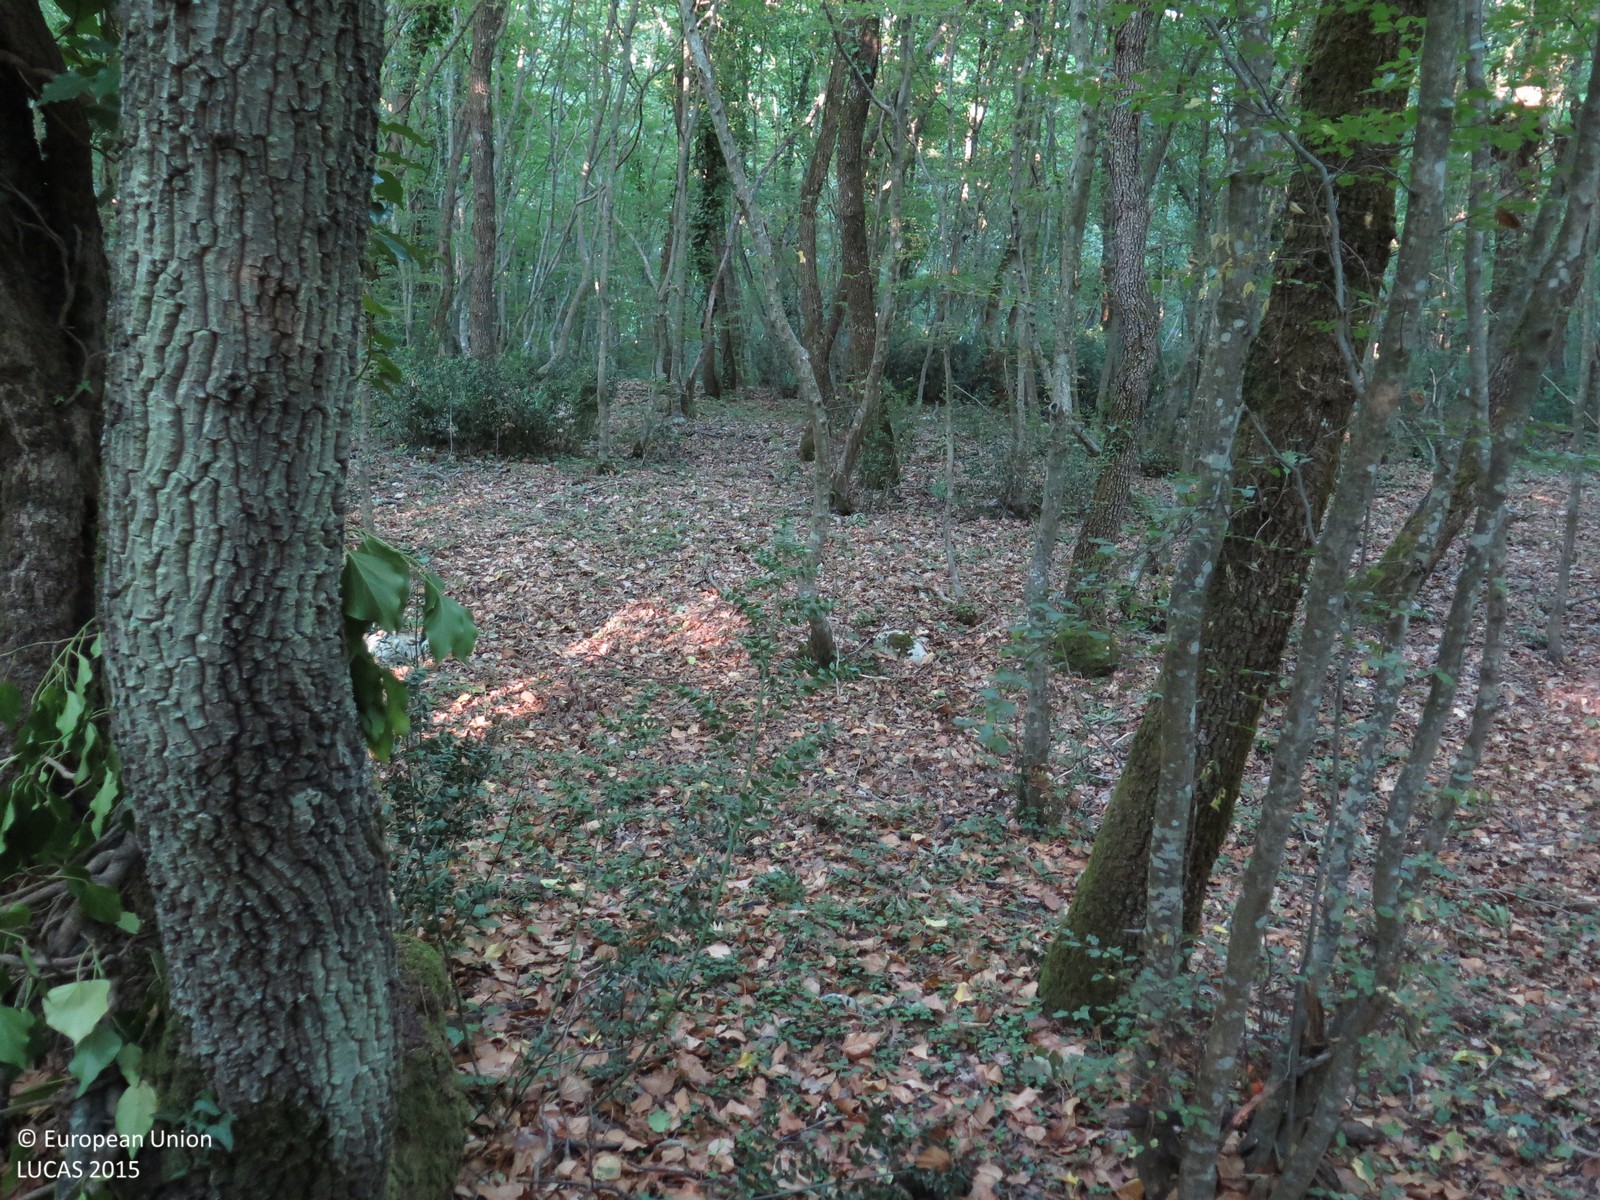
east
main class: Woodland
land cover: Broadleaved woodland
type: beech forest
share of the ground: > 75 %
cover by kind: broadleaved forest trees 100 %
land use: Semi-natural and natural areas not in use
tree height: > 5 m
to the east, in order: Broadleaved woodland; Grassland with sparse tree/shrub cover; Shrubland with sparse tree cover; Grass margins; Other bare soil; Grassland without tree/shrub cover; Broadleaved woodland; Rocks and stones; Broadleaved woodland
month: June
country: HR
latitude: 45.1673
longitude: 13.7480
